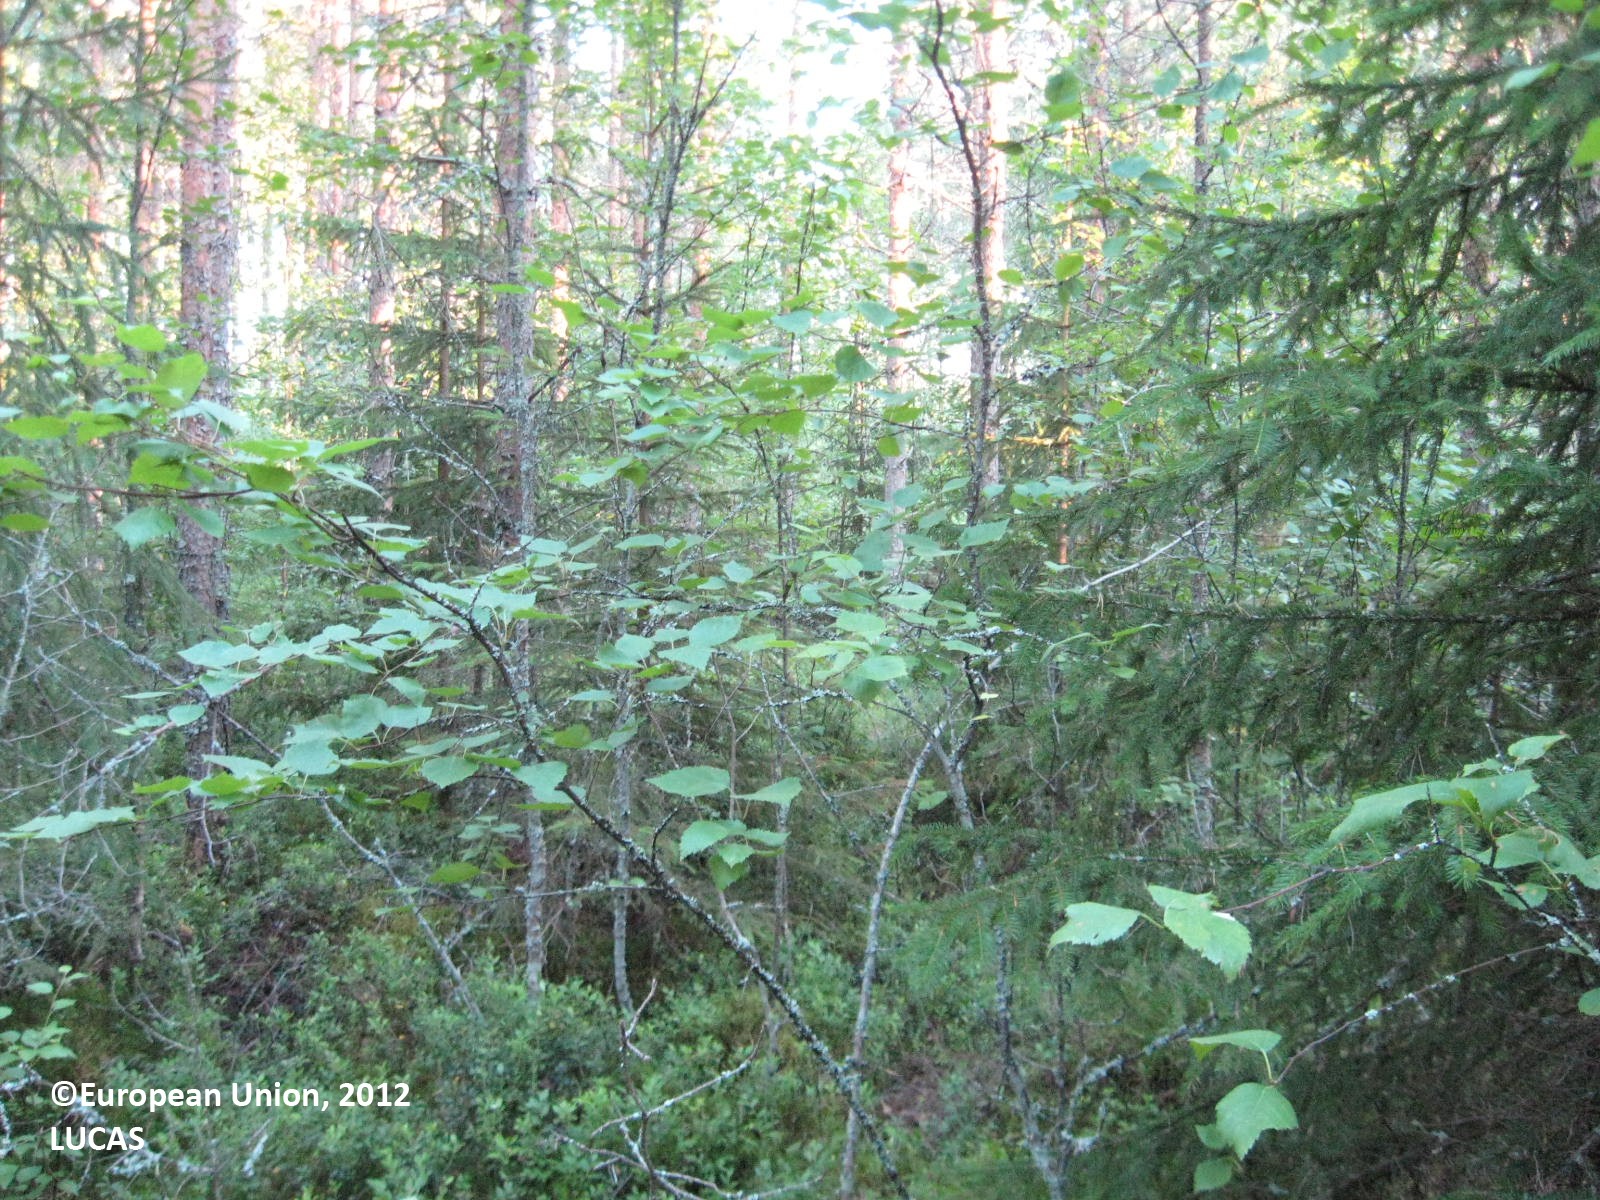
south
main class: Woodland
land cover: Pine dominated mixed woodland
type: boreal forest
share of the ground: > 75 %
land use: Forestry
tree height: > 5 m
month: July
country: FI
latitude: 62.4179
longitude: 21.6027
